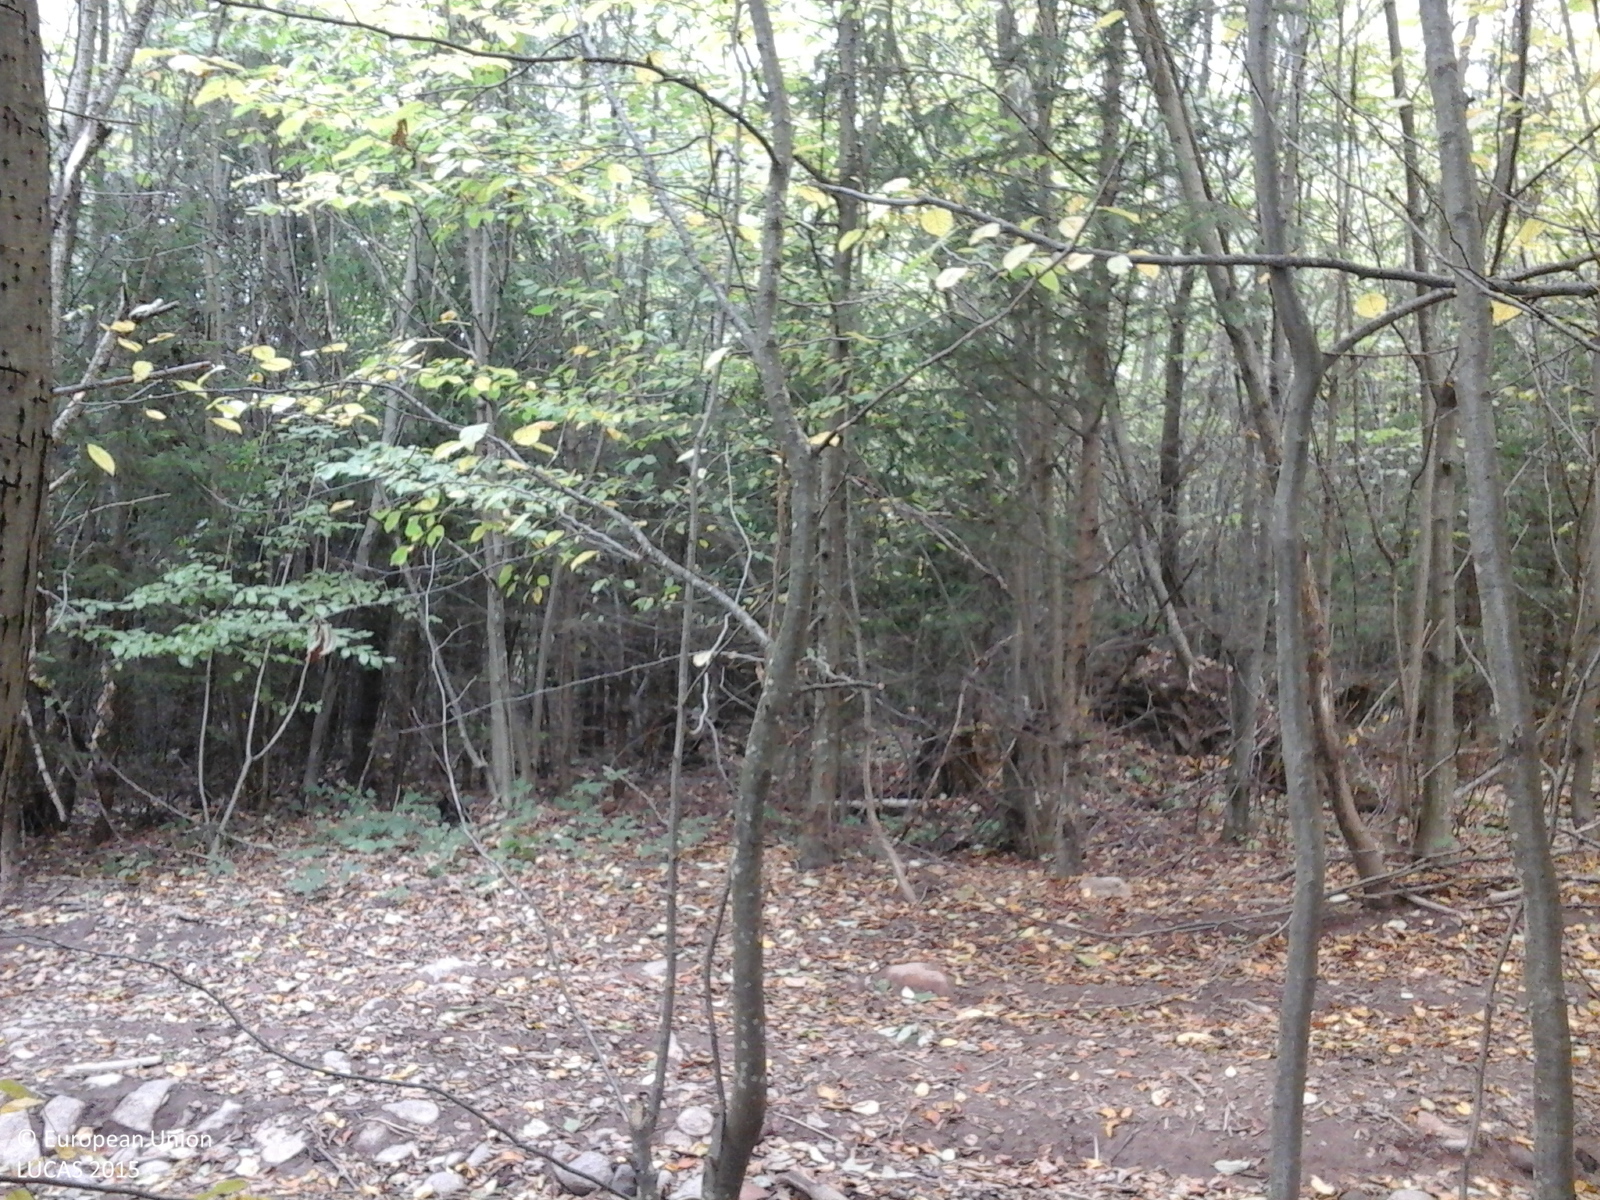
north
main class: Woodland
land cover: Broadleaved woodland
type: beech forest
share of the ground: > 75 %
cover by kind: broadleaved forest trees 100 %
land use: Forestry
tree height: > 5 m
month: October
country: RO
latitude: 46.4609
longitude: 25.4859
